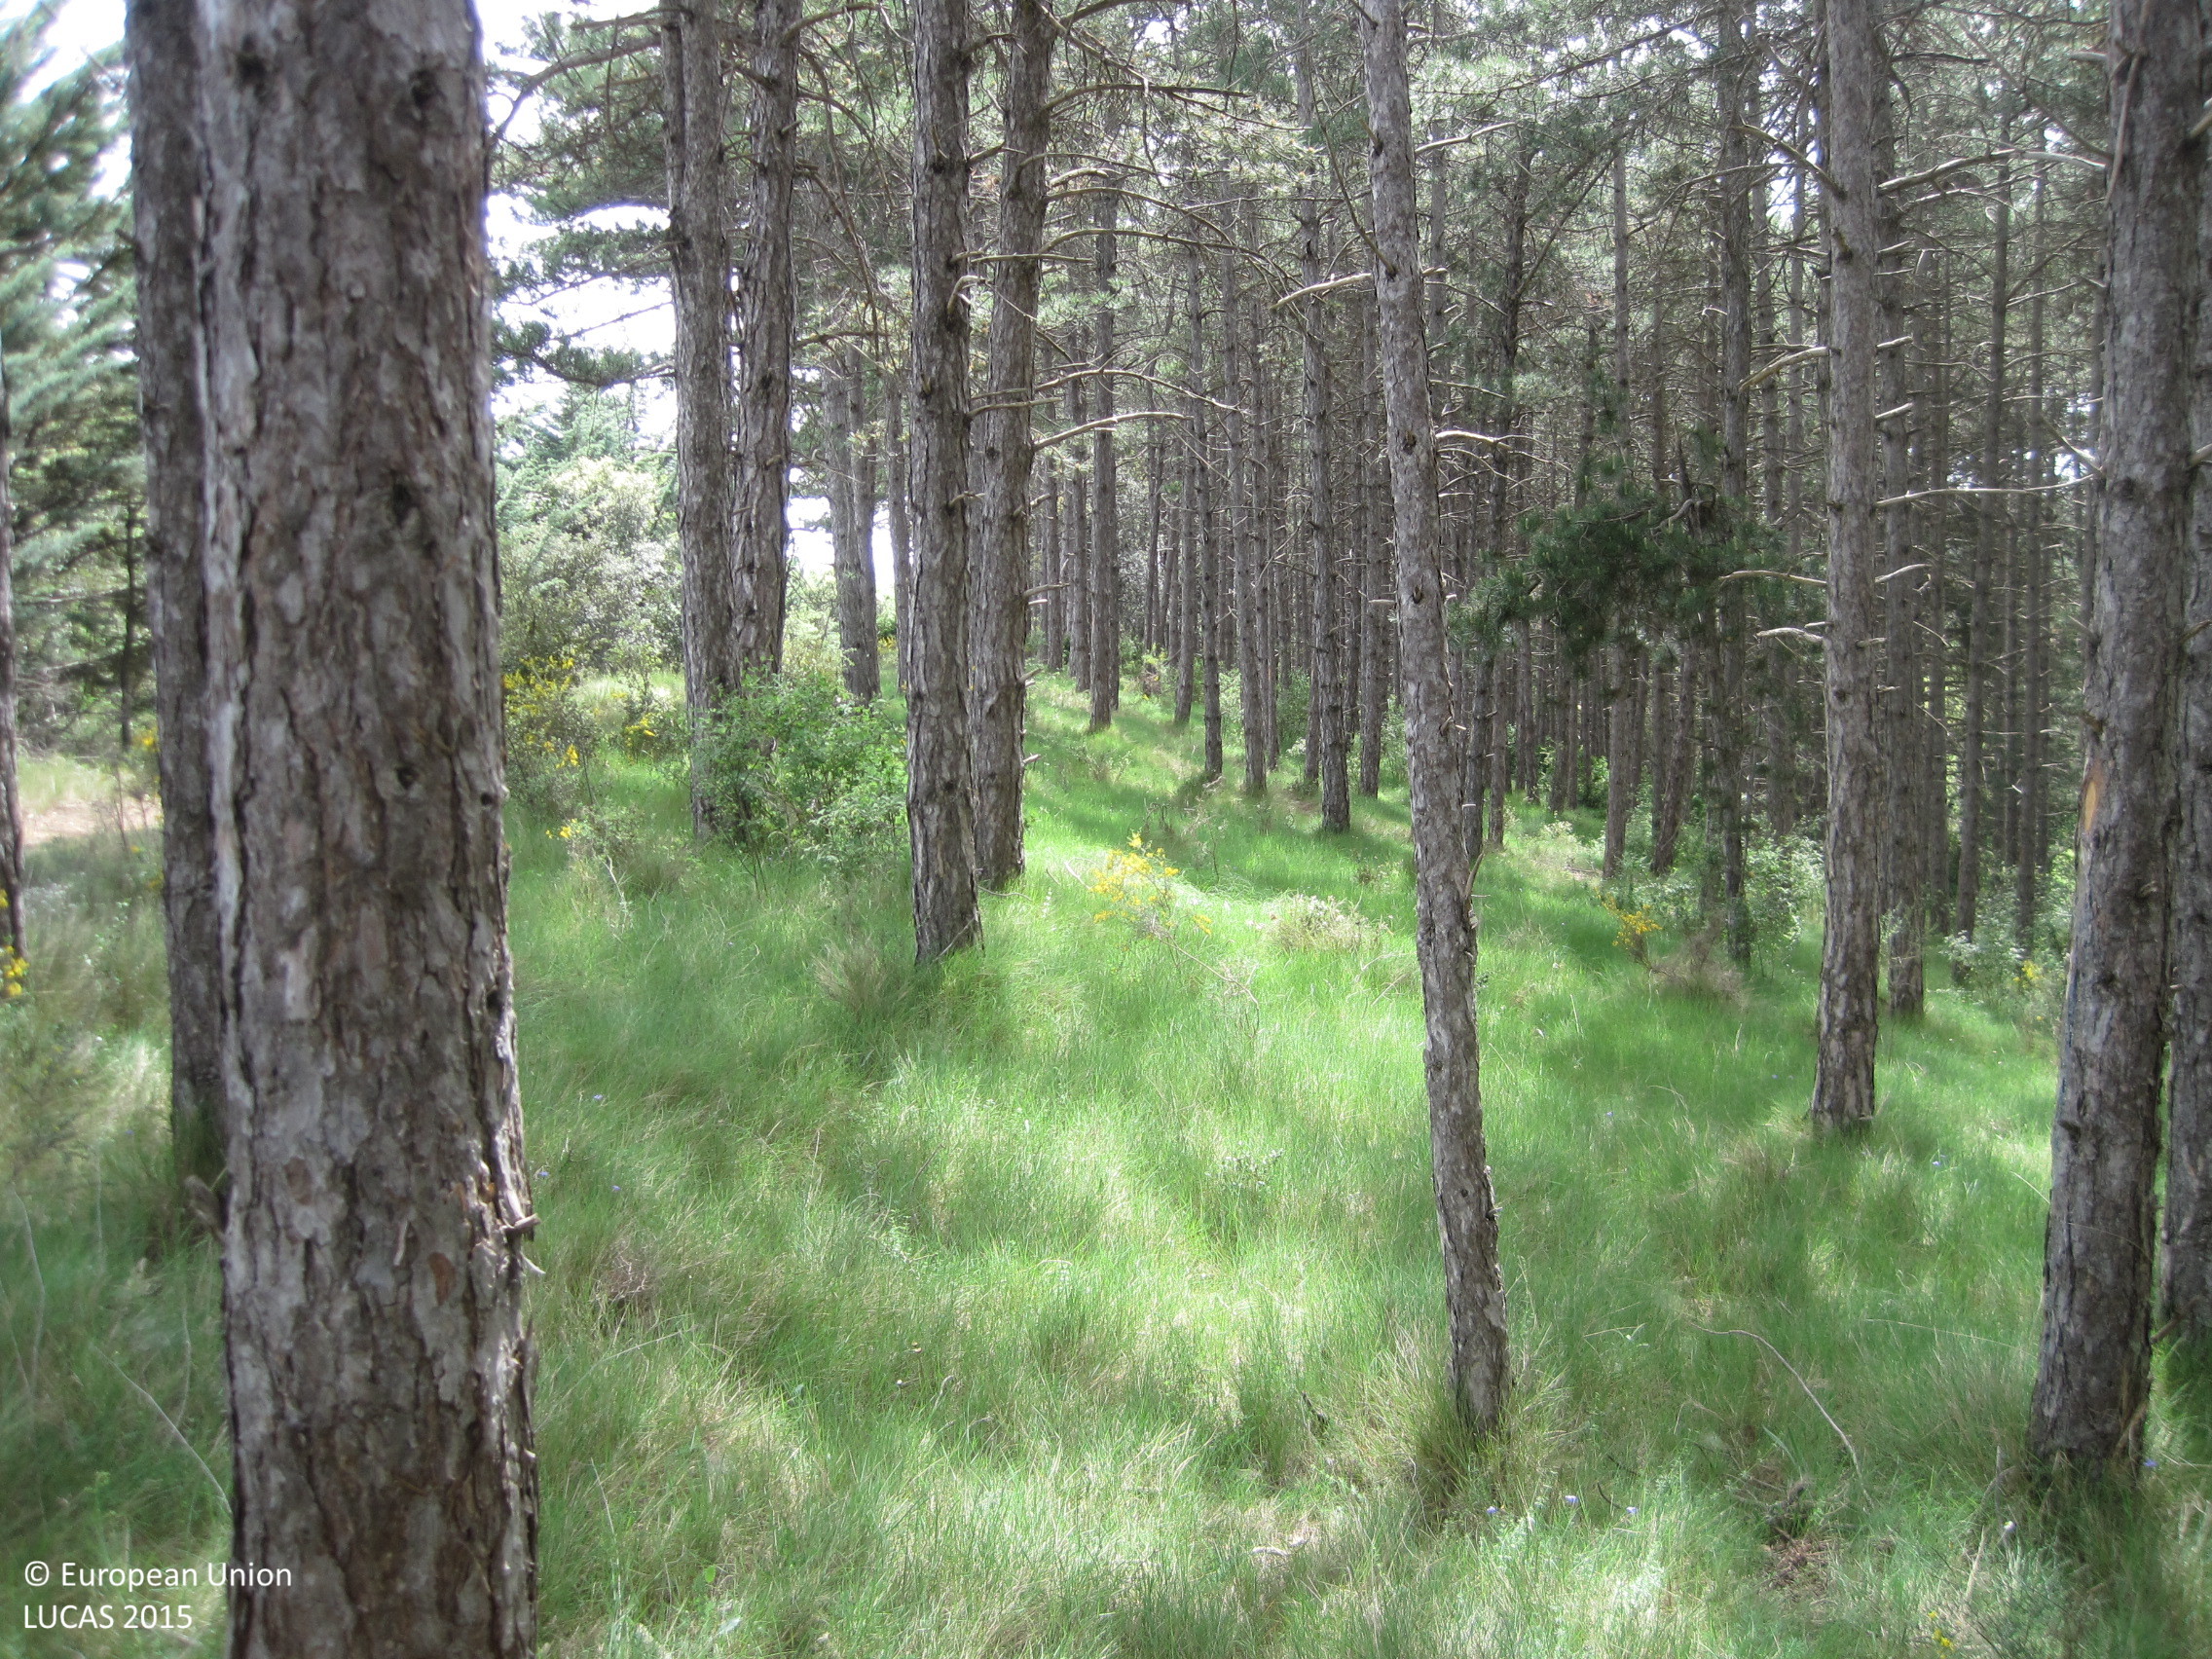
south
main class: Woodland
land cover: Pine dominated coniferous woodland
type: coniferous forest of the mediterranean region
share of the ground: > 75 %
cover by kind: coniferous forest trees 100 %
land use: Forestry
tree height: > 5 m
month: May
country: ES
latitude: 42.6372
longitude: -1.6351
